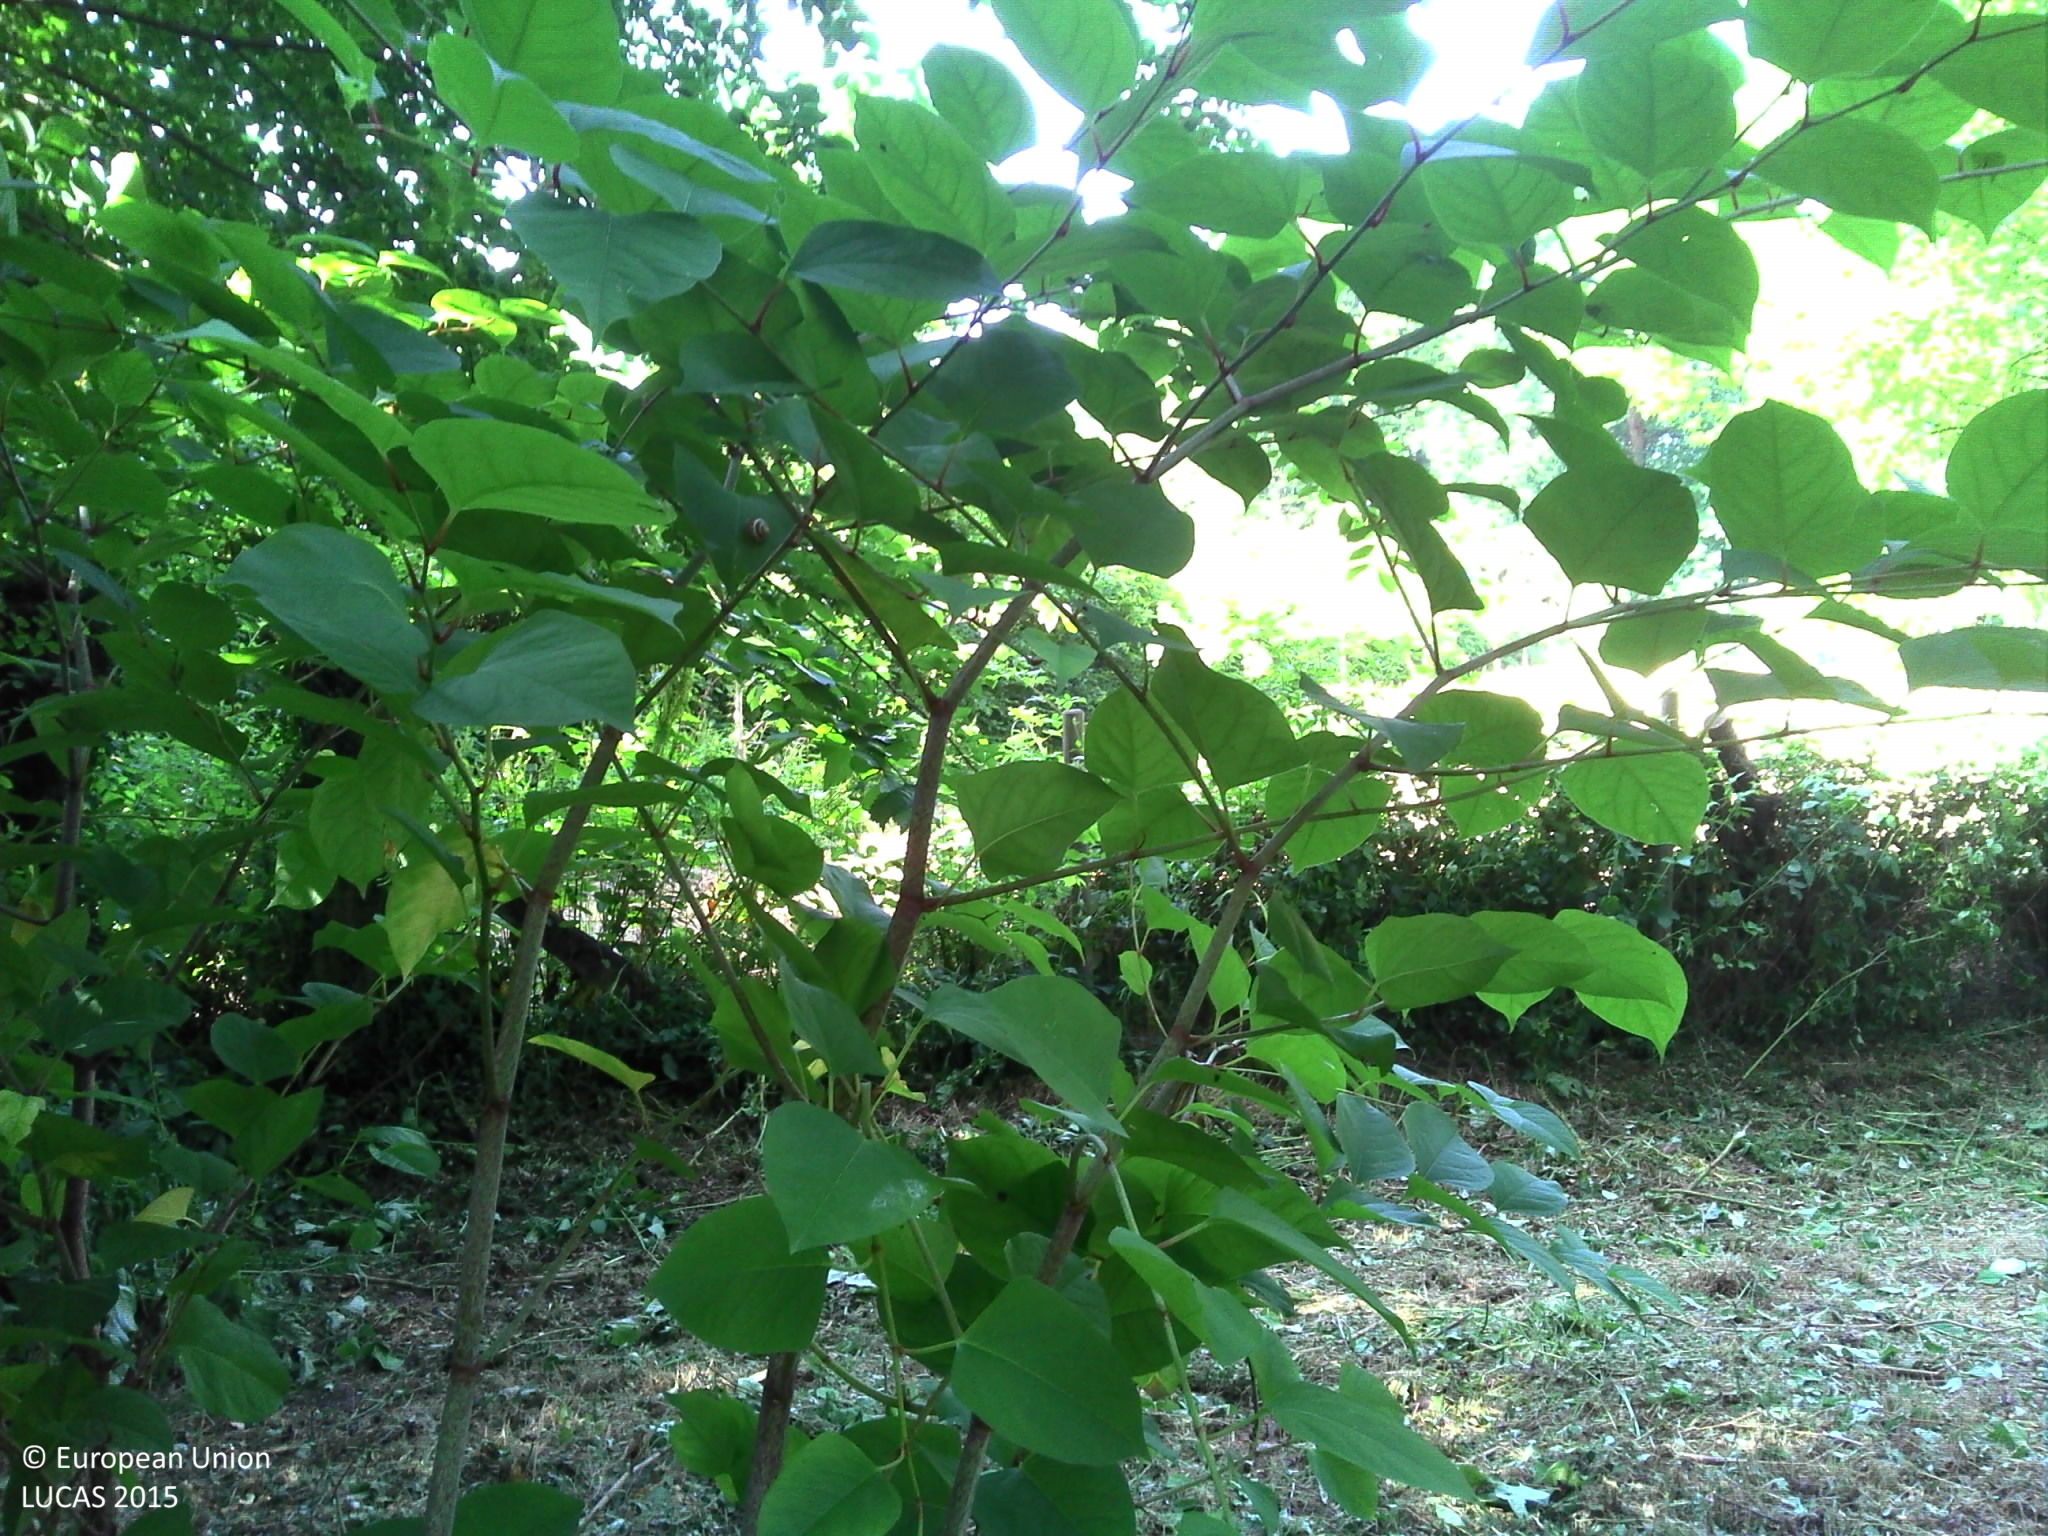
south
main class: Woodland
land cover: Broadleaved woodland
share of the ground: > 75 %
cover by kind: broadleaved forest trees 75 %, herbaceous plants 25 %
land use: Agriculture (excluding fallow land and kitchen gardens)
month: June
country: BE
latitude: 50.5175
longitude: 3.7454
